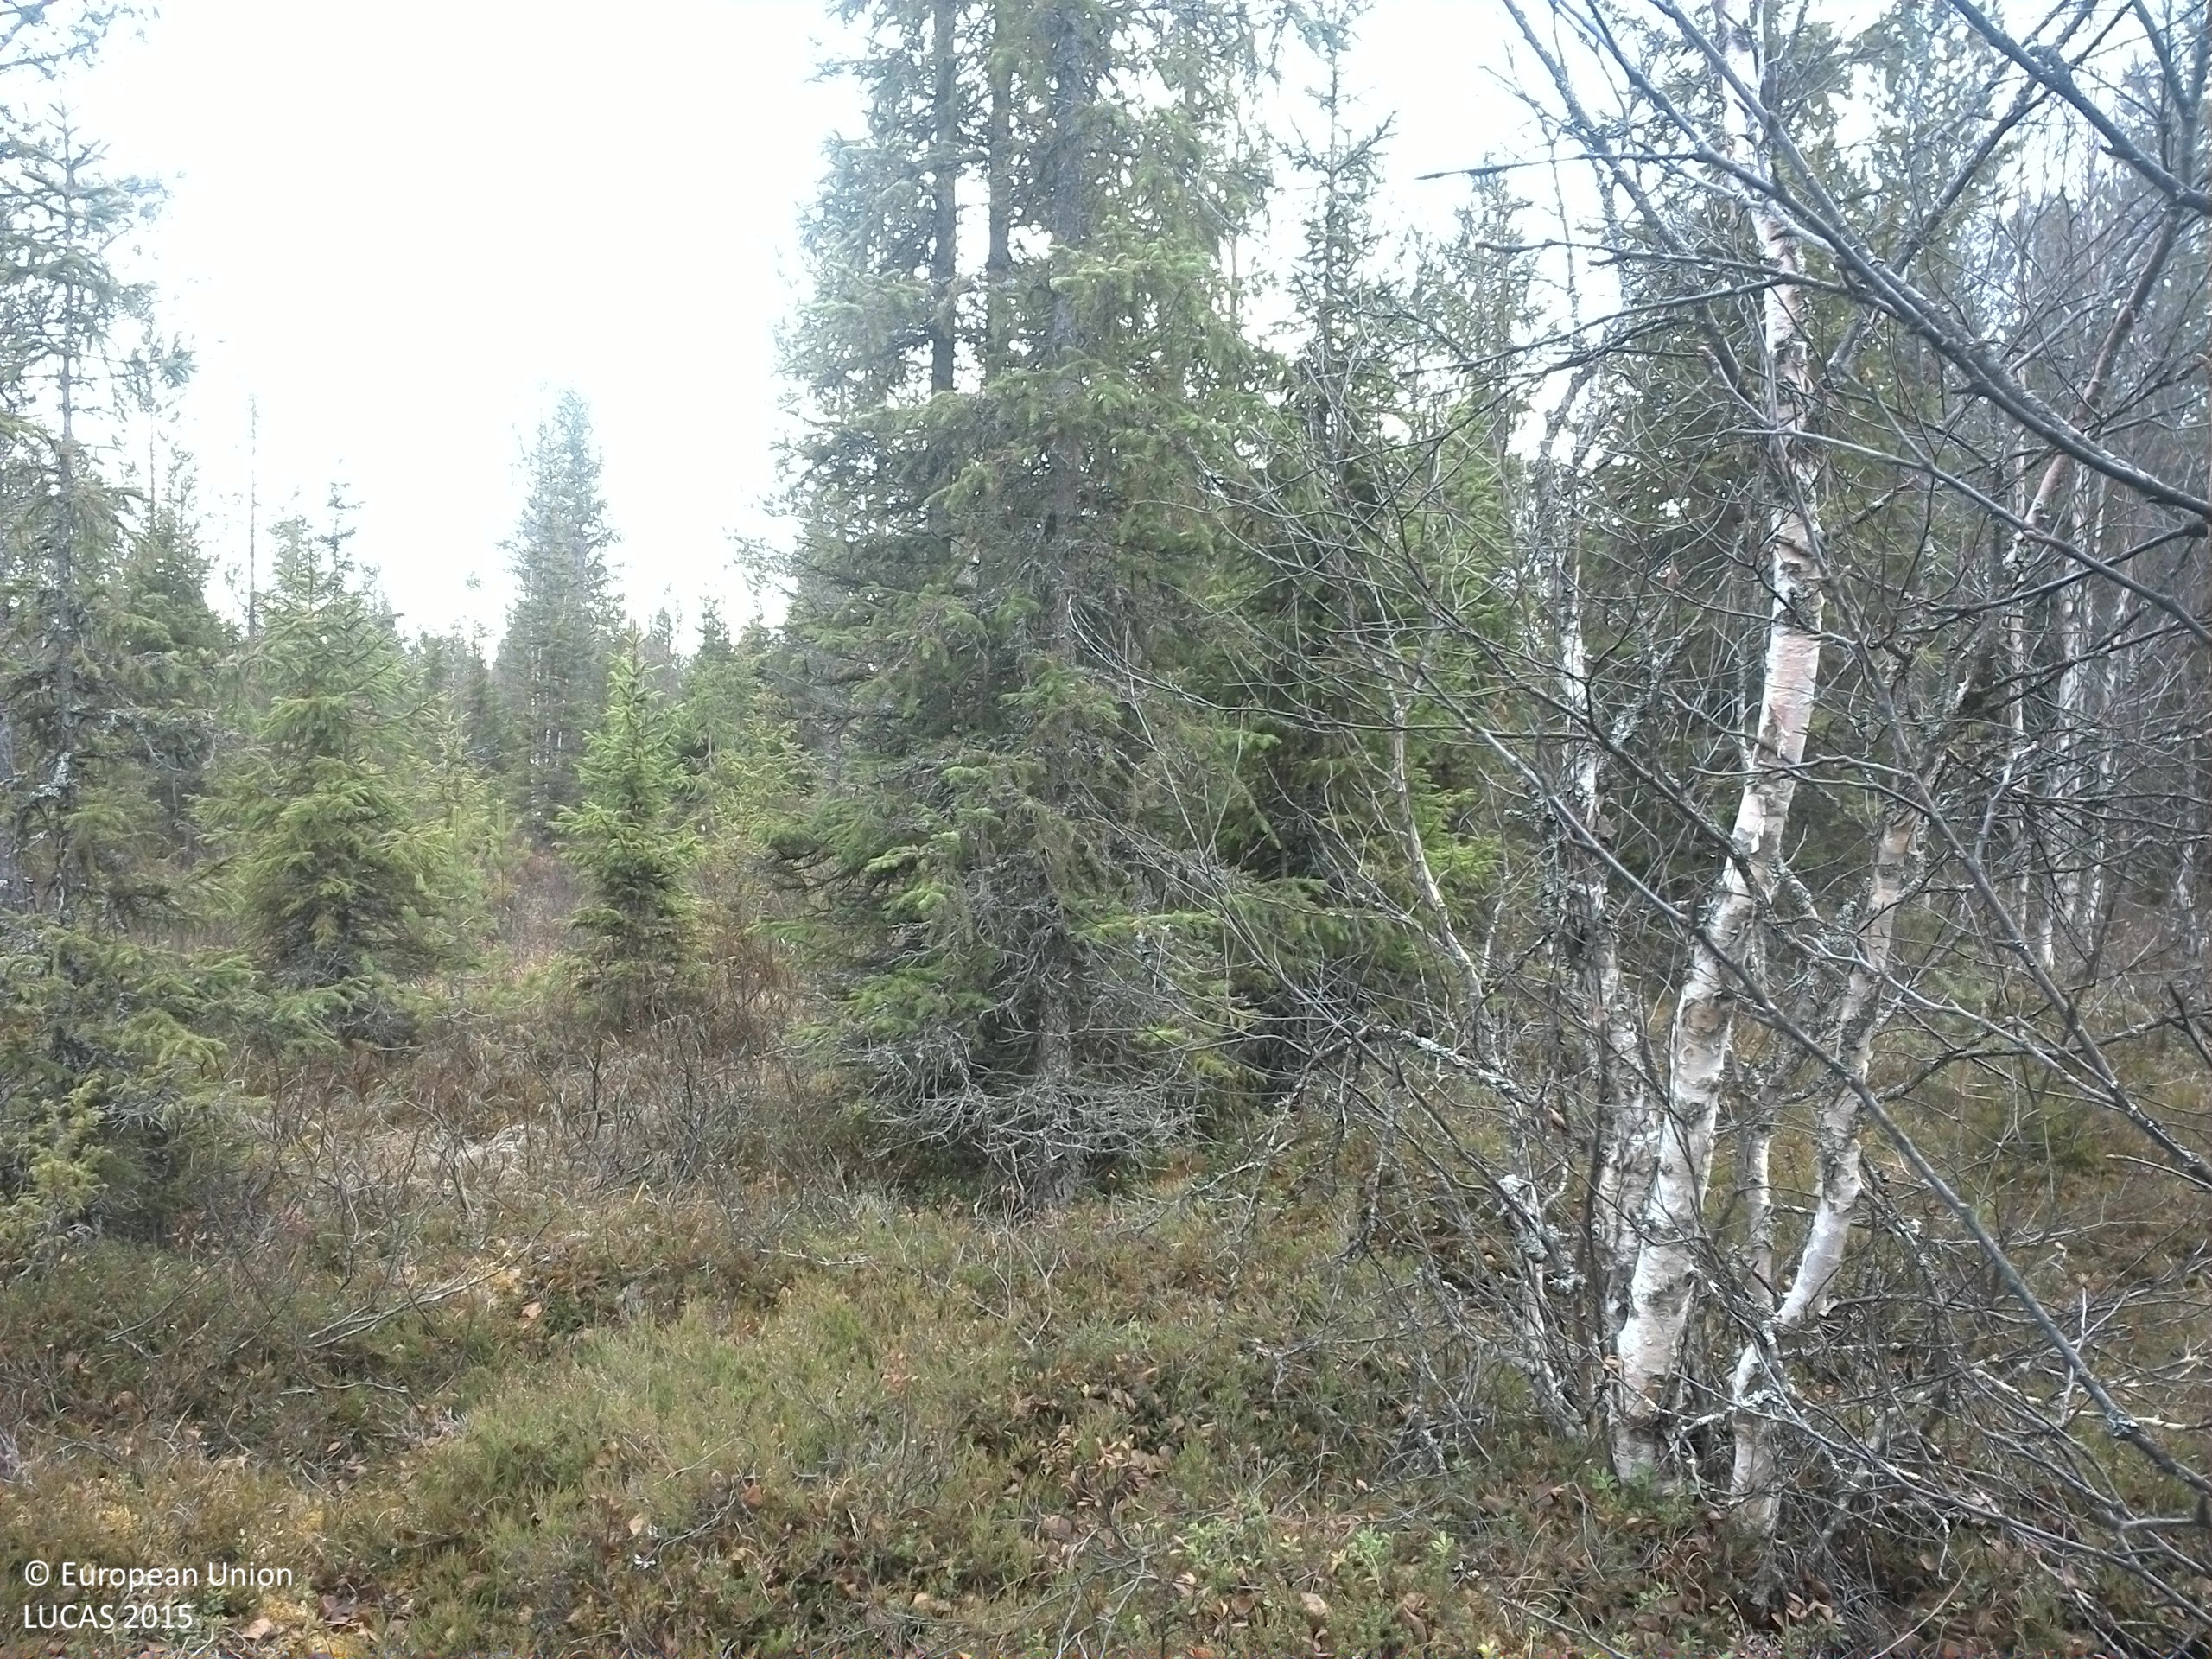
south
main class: Woodland
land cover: Spruce dominated mixed woodland
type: boreal forest
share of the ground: 25 - 50 %
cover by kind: shrubs 45 %, broadleaved forest trees 30 %, lichens and mosses 15 %, coniferous forest trees 10 %
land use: Forestry
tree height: > 5 m
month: October
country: SE
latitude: 64.2643
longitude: 15.5649
